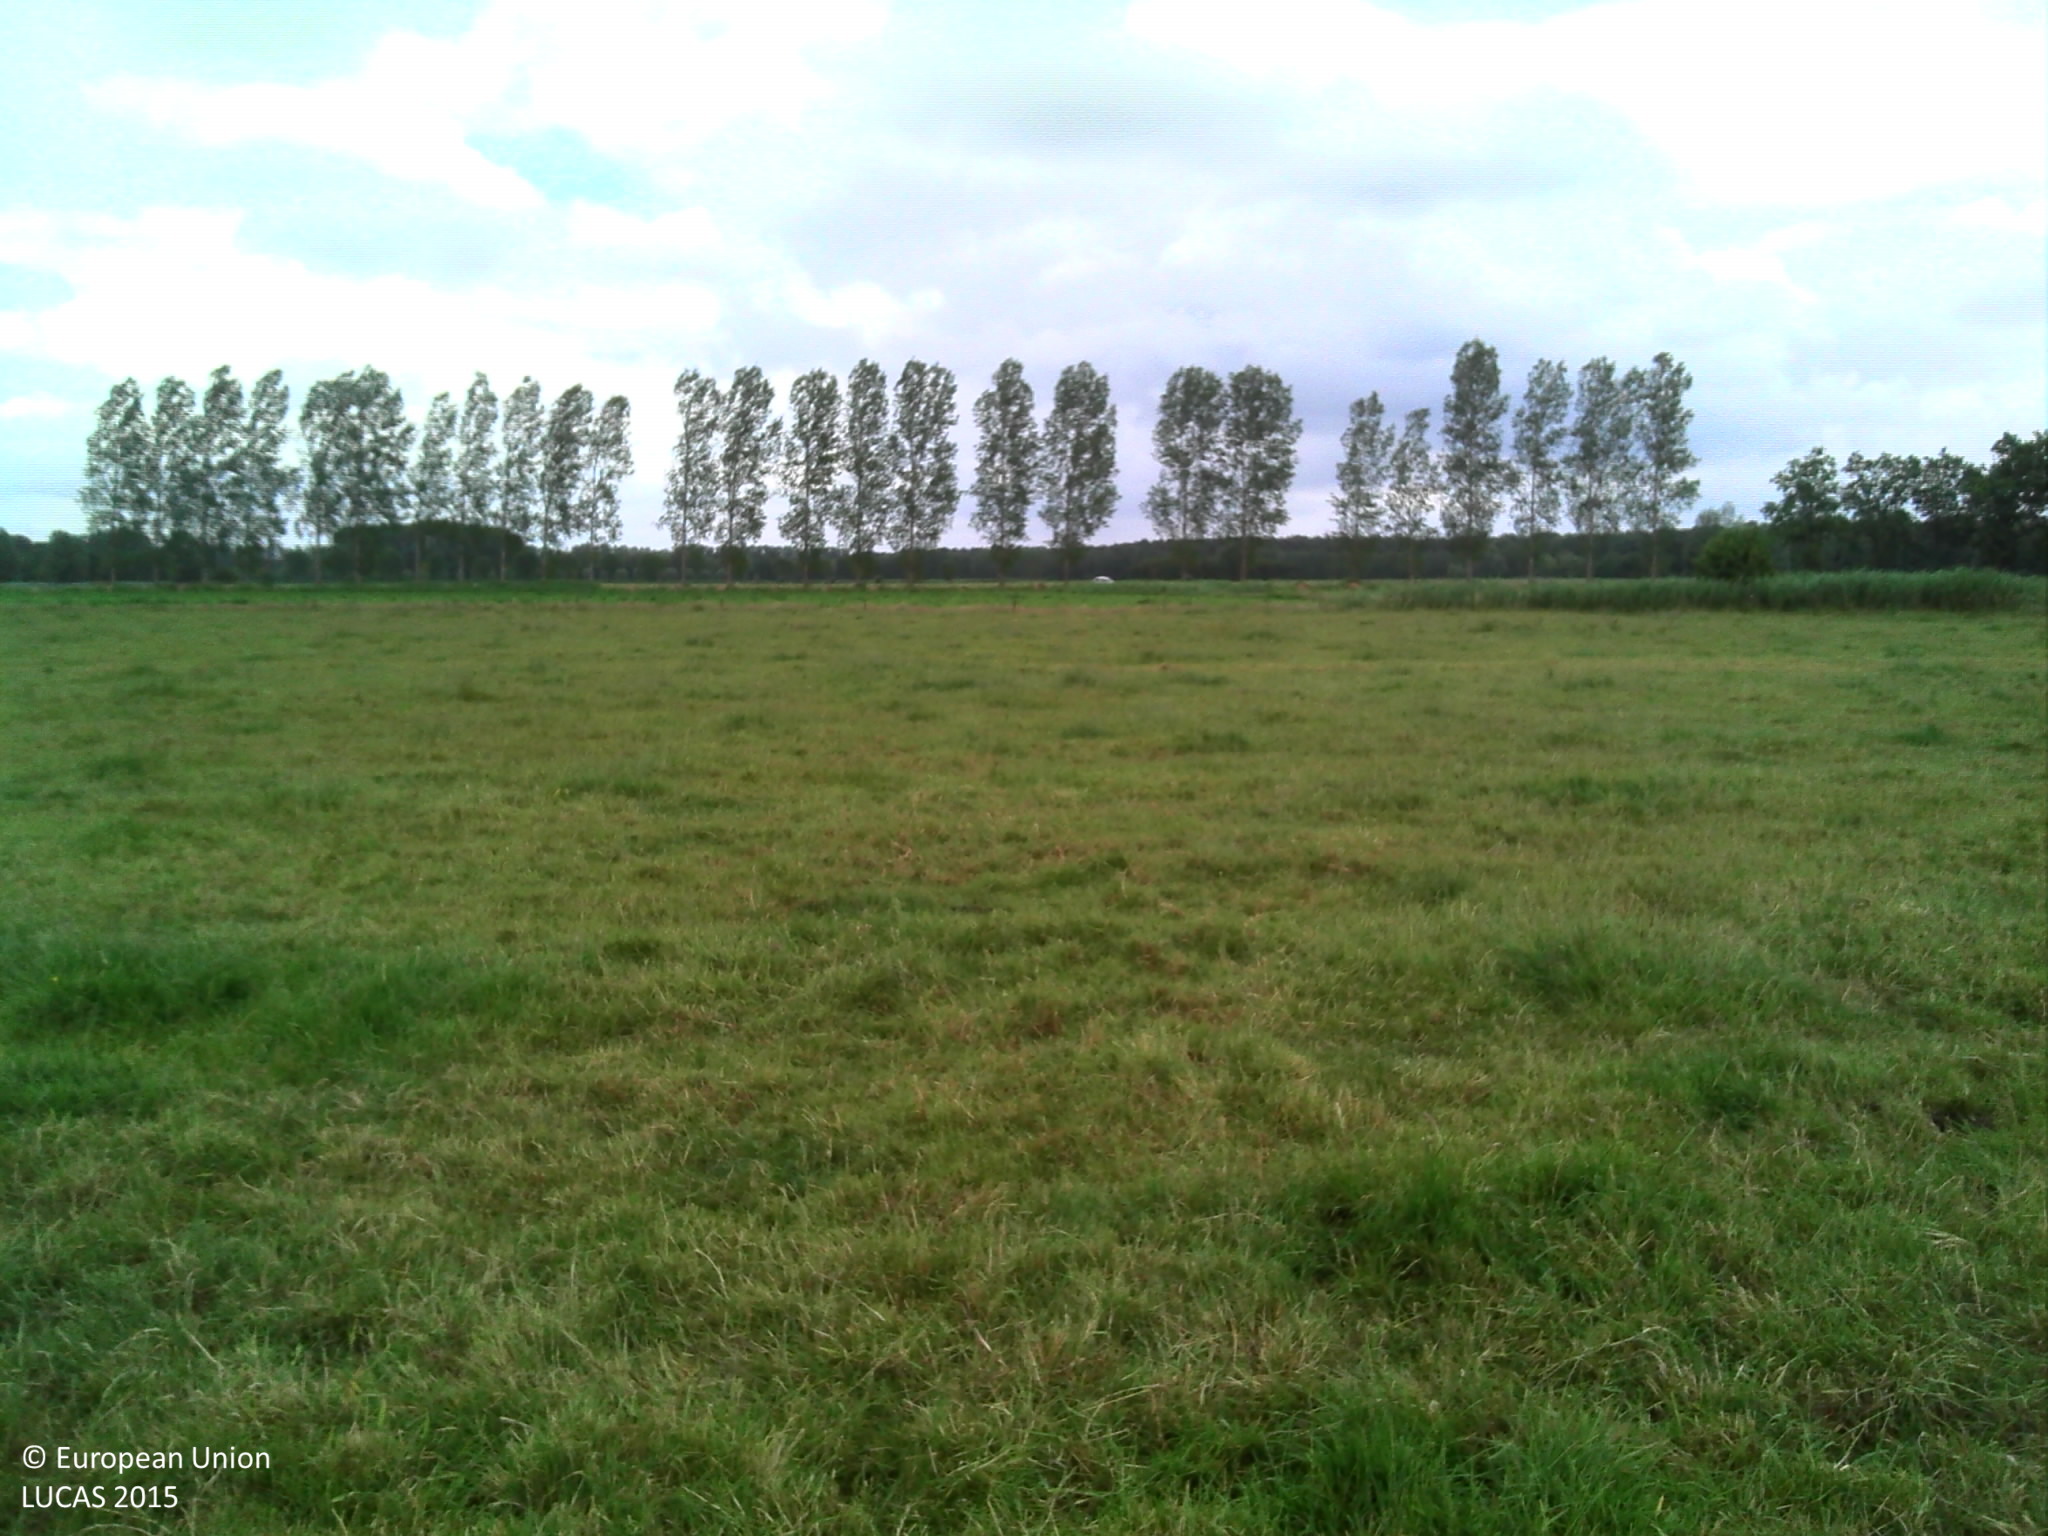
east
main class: Grassland
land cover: Grassland without tree/shrub cover
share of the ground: > 75 %
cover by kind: herbaceous plants 100 %
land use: Agriculture (excluding fallow land and kitchen gardens)
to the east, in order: Grassland without tree/shrub cover; Fences; Grass margins; Ditches and canals; Grass margins; Sugar beet; Grass margins; Inland fresh running water; Grass margins; Lines of trees; Grass margins; Paved roads, cycling and walking lanes; Grass margins; Lines of trees; Grass margins; Ditches and canals; Grass margins; Common wheat
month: June
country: BE
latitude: 51.1951
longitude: 3.9408
